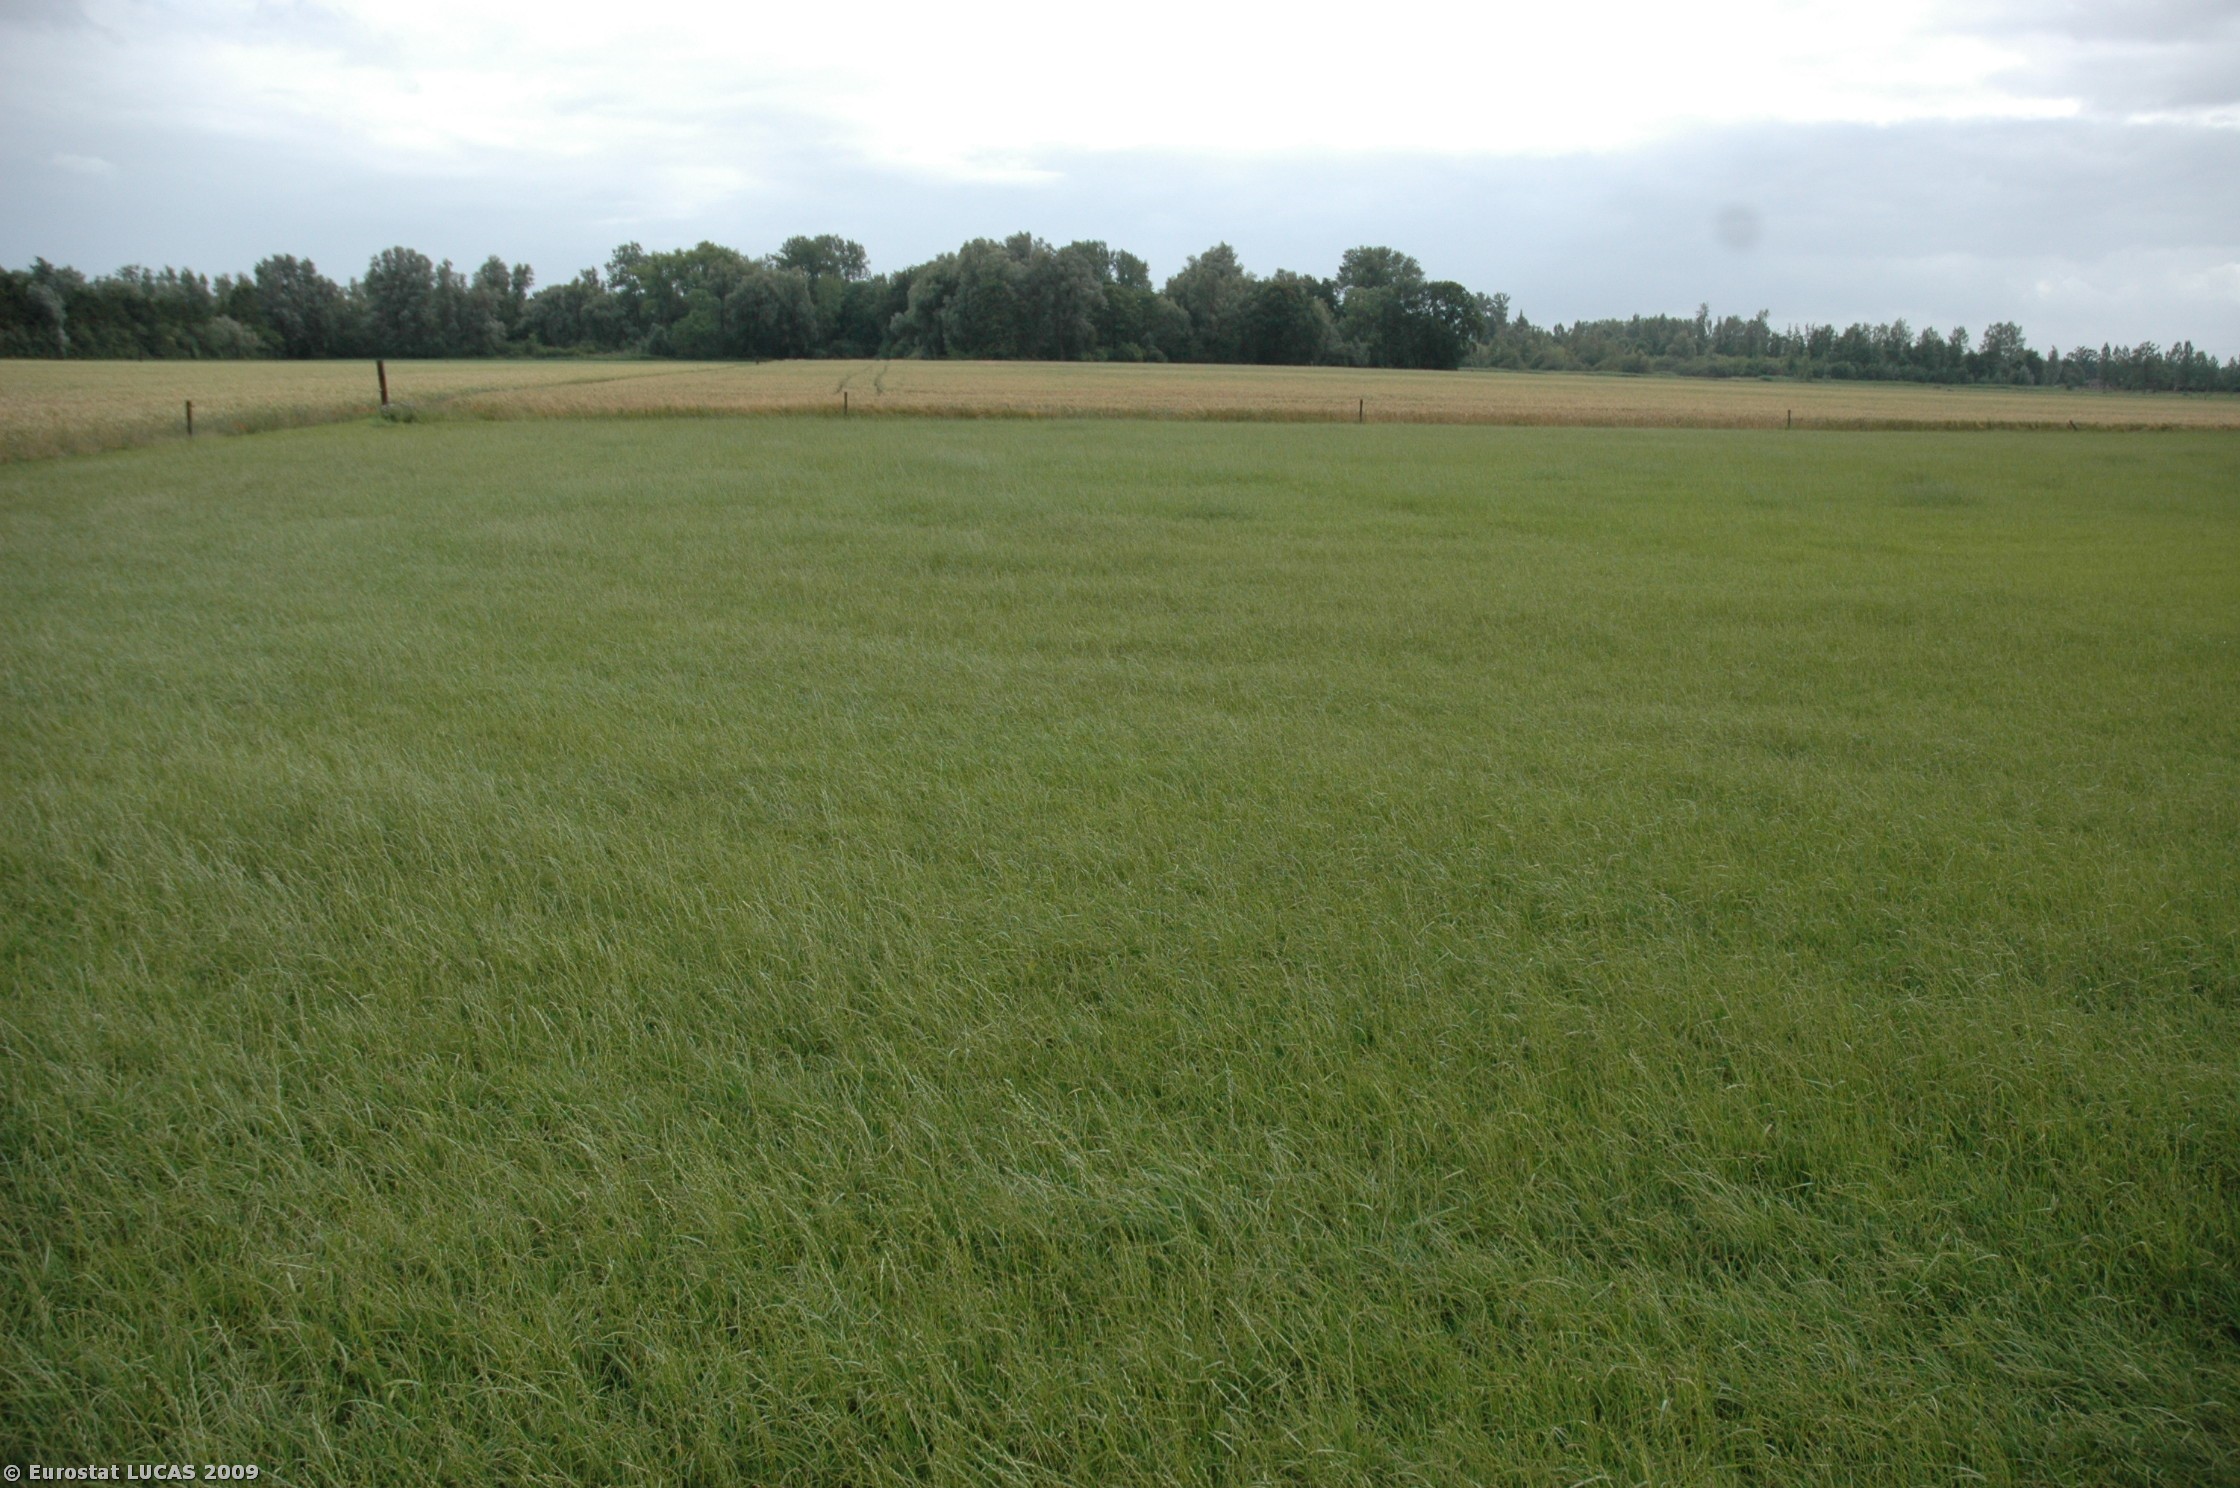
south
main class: Cropland
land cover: Common wheat
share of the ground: > 75 %
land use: Agriculture (excluding fallow land and kitchen gardens)
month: July
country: NL
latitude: 52.2950
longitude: 6.0844
